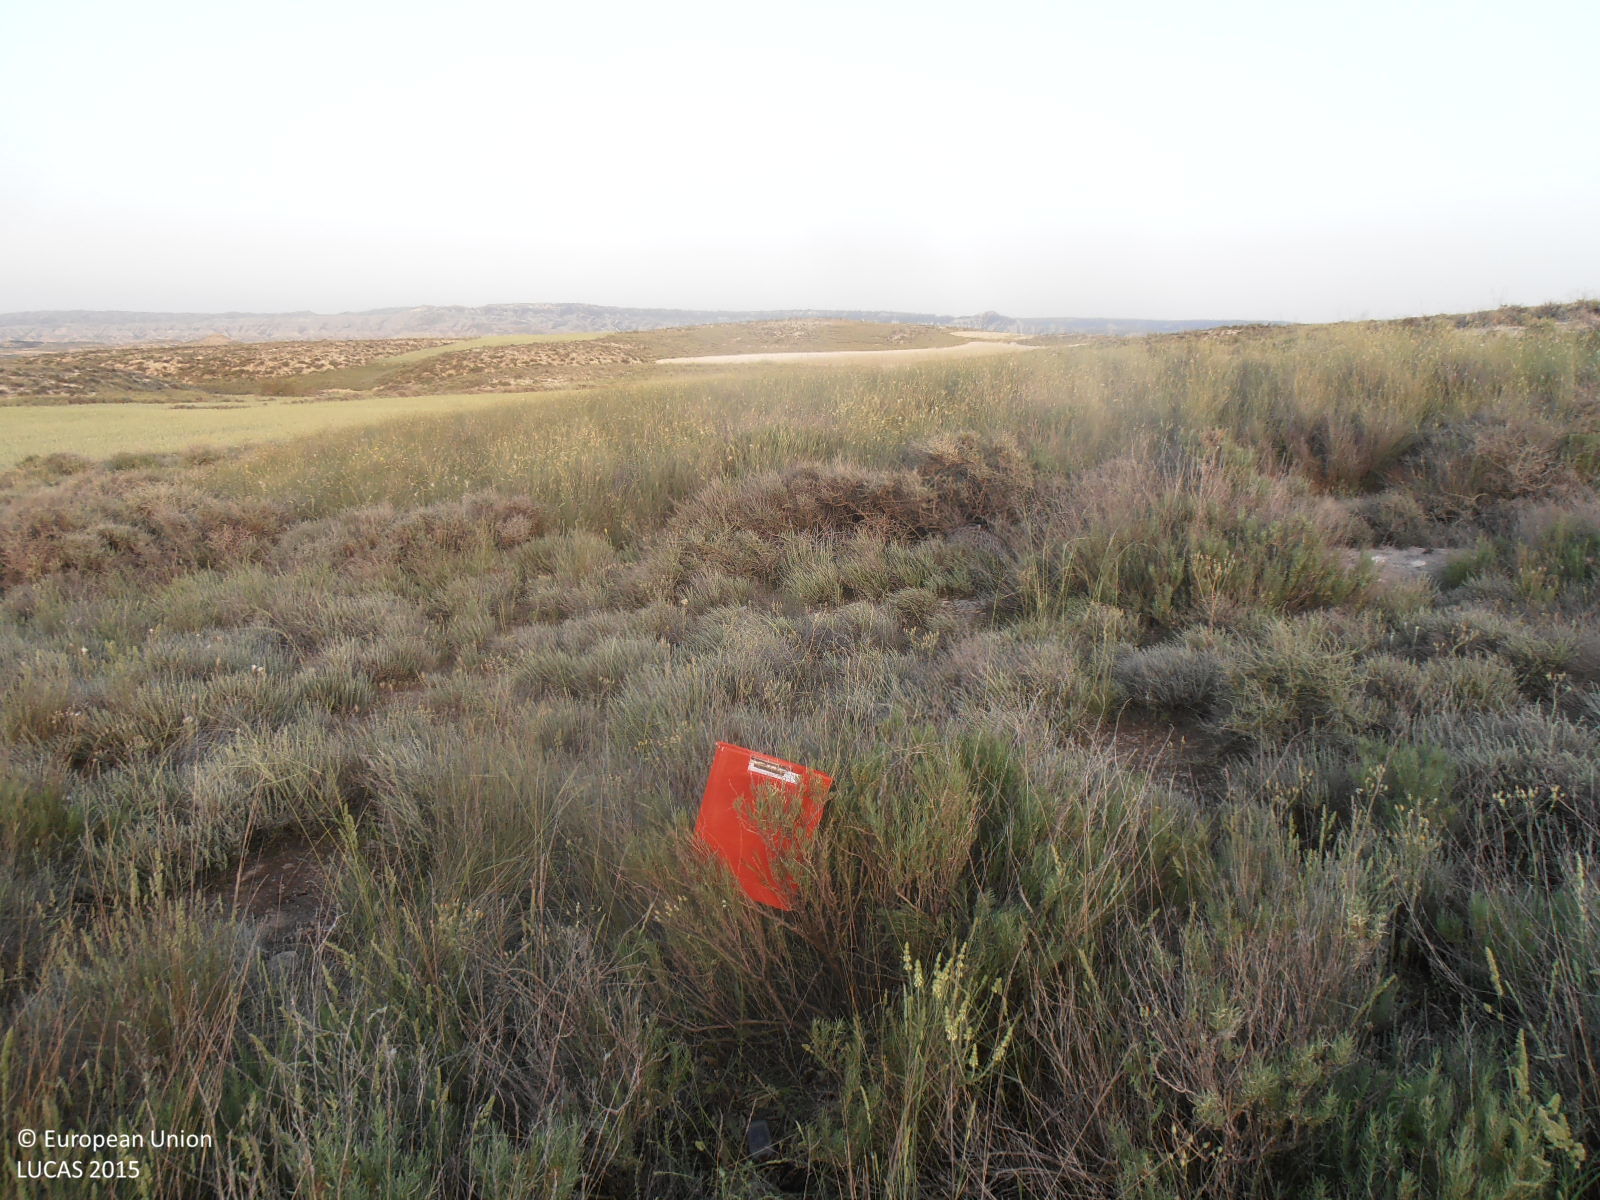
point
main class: Shrubland
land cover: Shrubland without tree cover
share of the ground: > 75 %
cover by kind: shrubs 90 %, herbaceous plants 10 %
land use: Semi-natural and natural areas not in use
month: May
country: ES
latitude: 41.5567
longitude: -1.0409
